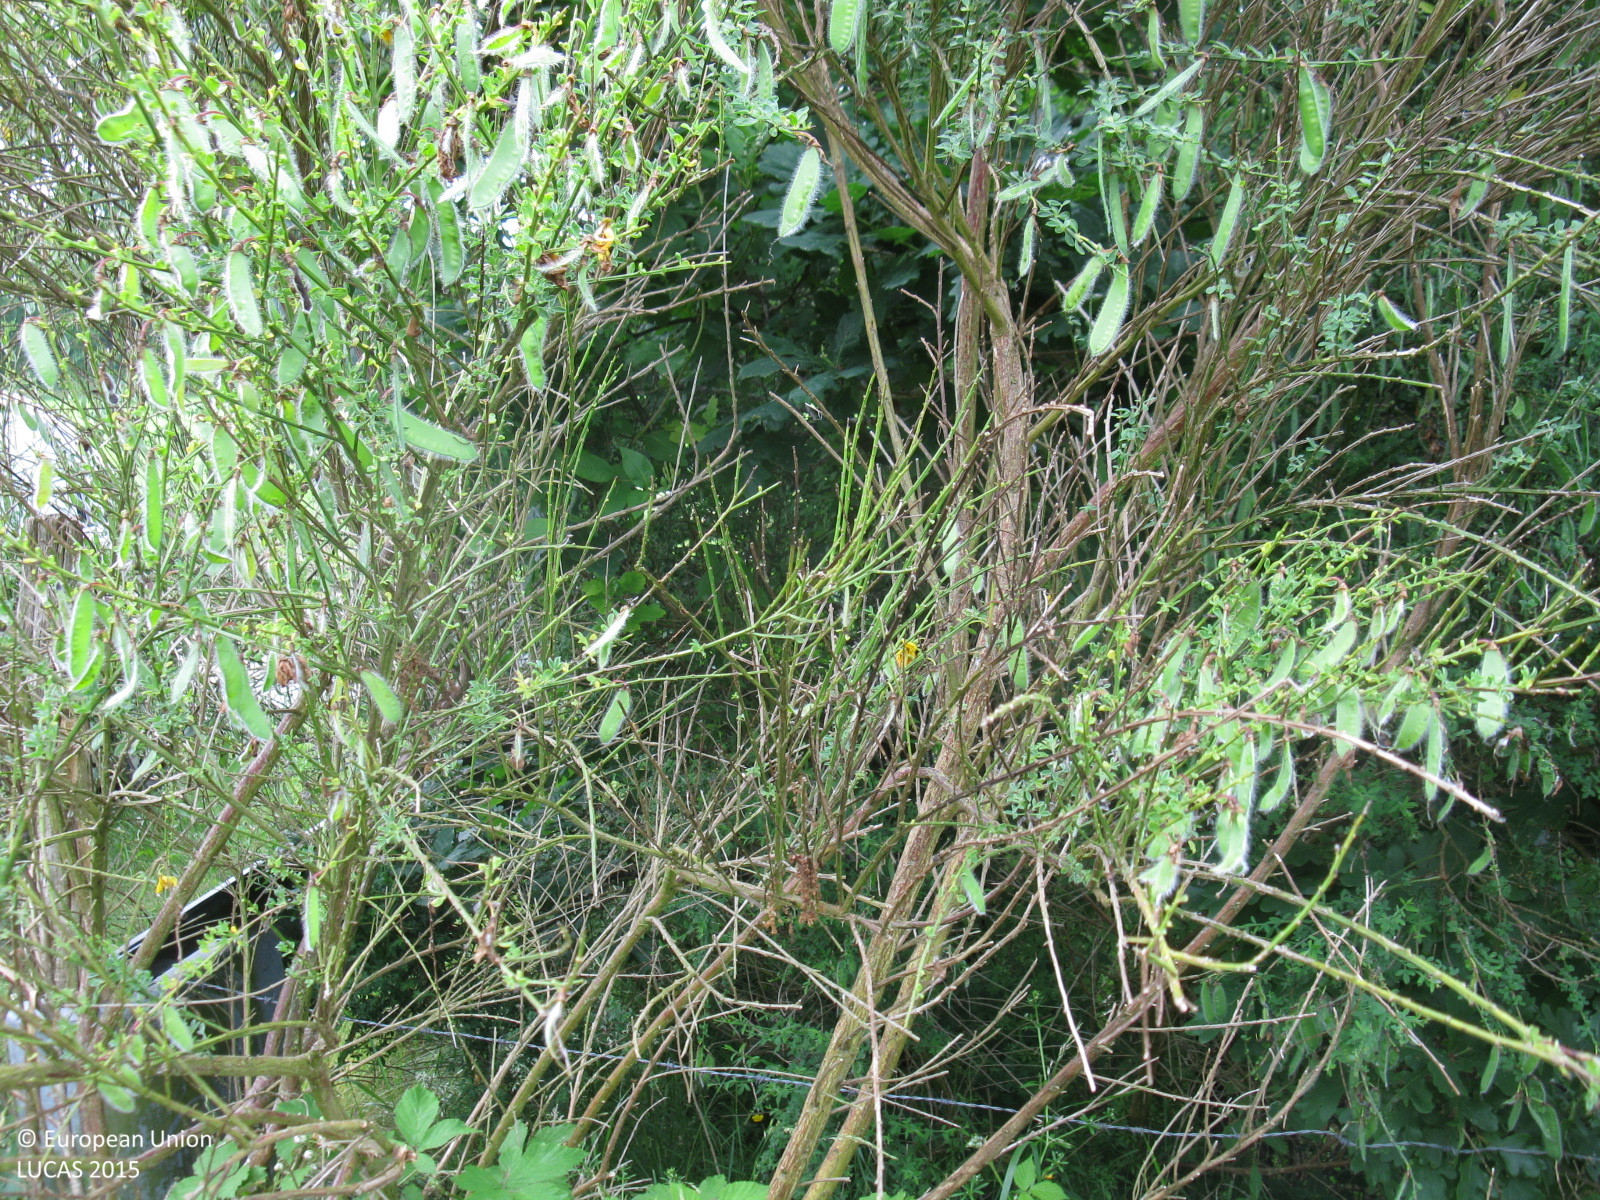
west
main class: Grassland
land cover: Grassland without tree/shrub cover
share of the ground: > 75 %
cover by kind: herbaceous plants 100 %
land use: Agriculture (excluding fallow land and kitchen gardens)
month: June
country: DE
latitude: 53.5091
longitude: 7.8746
